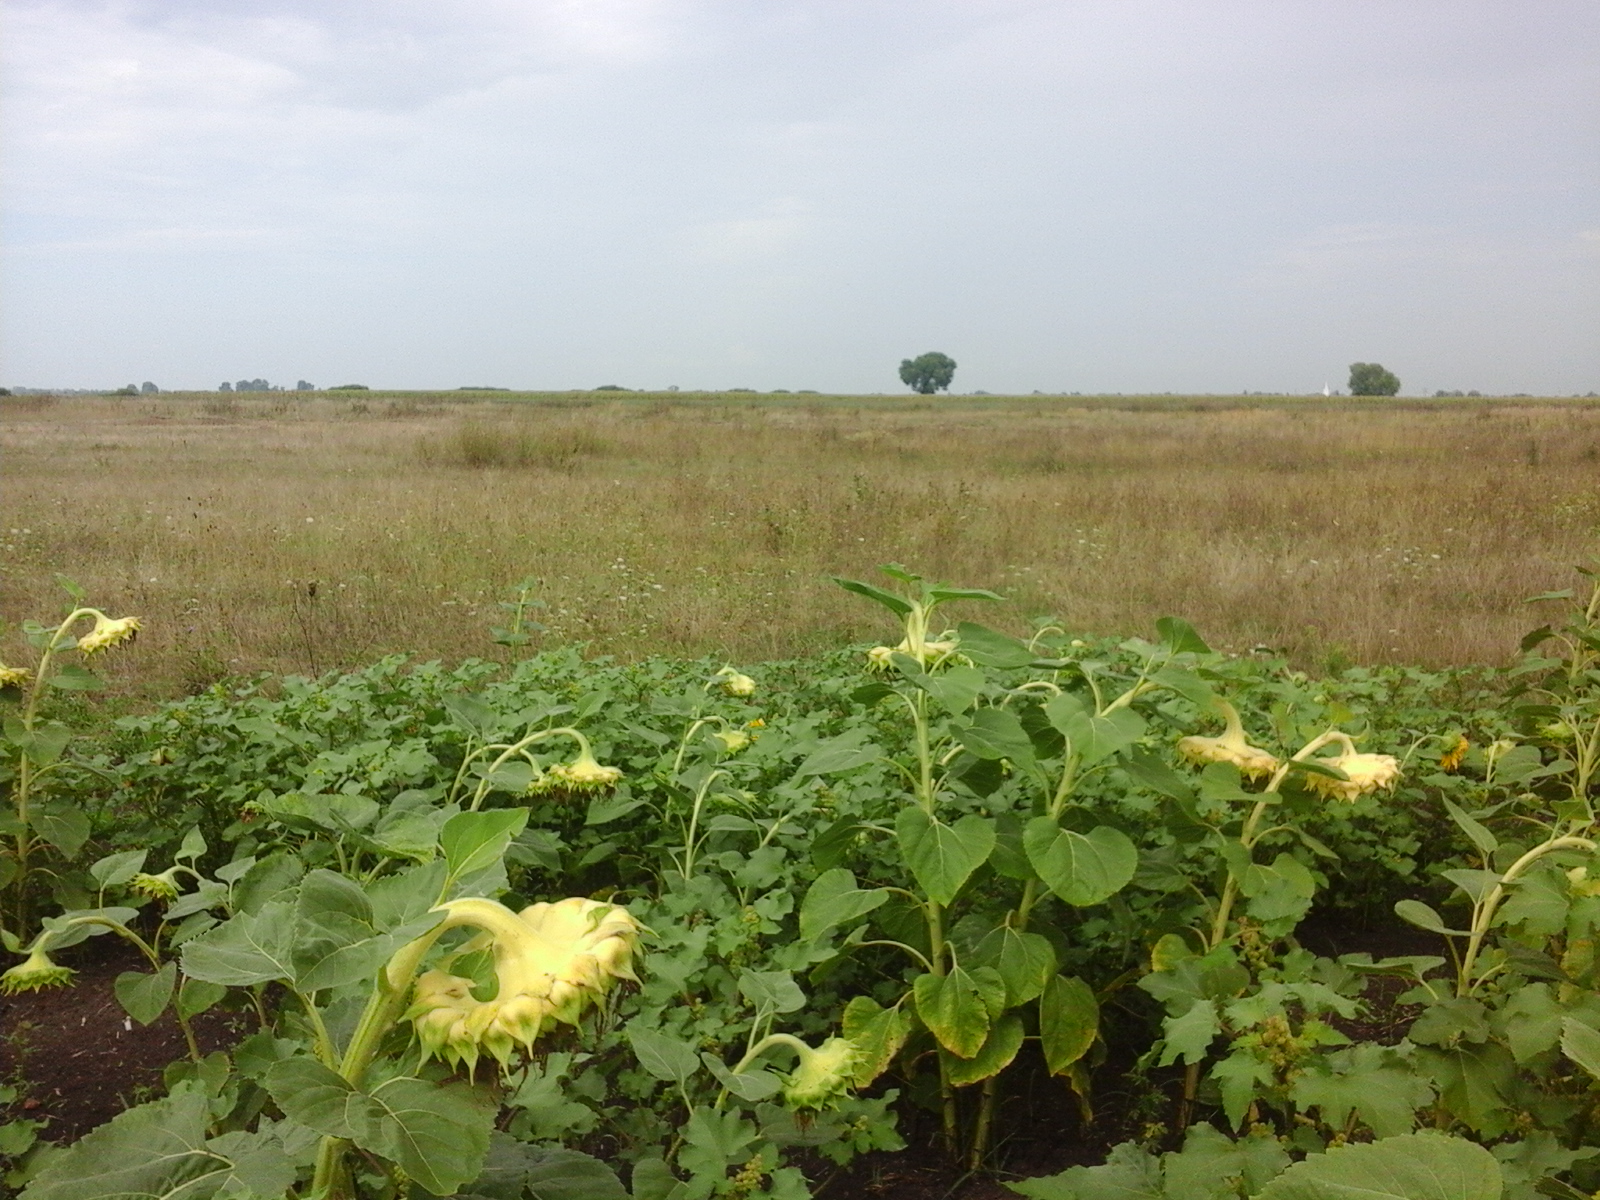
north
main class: Cropland
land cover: Sunflower
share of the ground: > 75 %
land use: Agriculture (excluding fallow land and kitchen gardens)
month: August
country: RO
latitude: 46.6207
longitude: 21.4912
